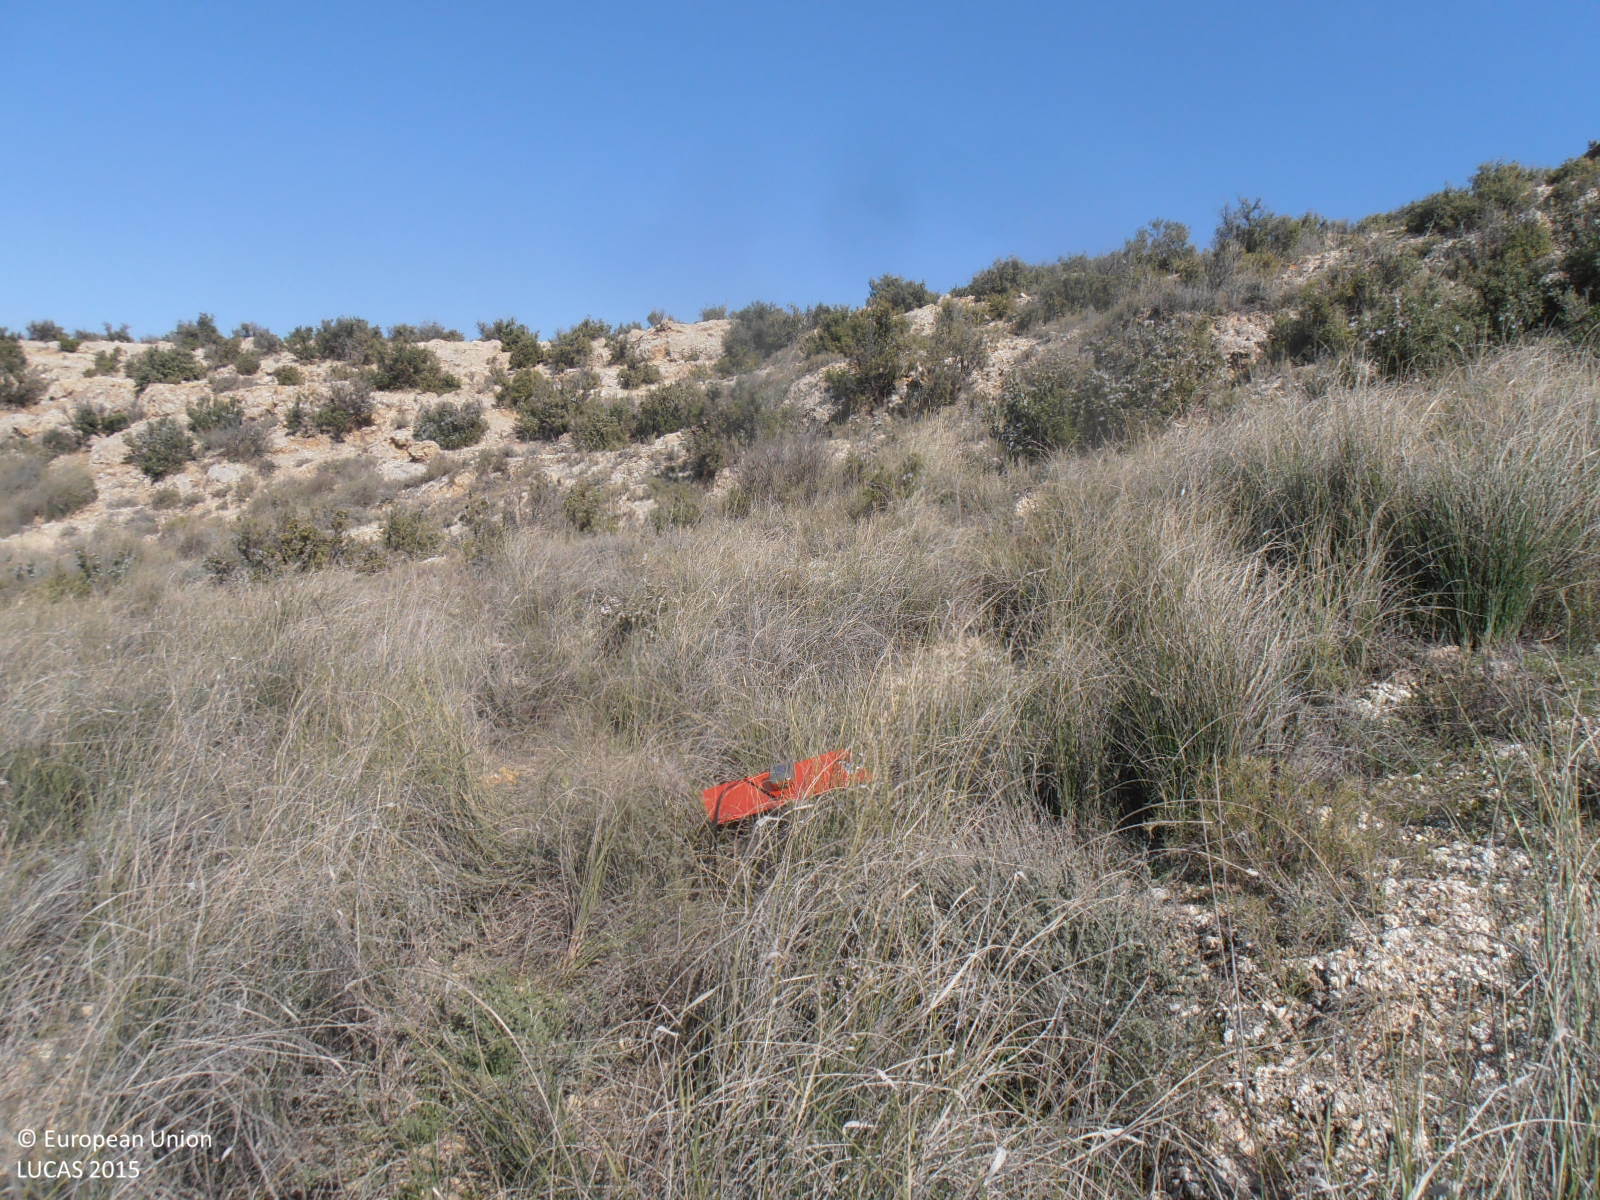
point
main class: Shrubland
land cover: Shrubland without tree cover
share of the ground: 50 - 75 %
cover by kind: shrubs 55 %, consolidated bare surface 45 %
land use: Semi-natural and natural areas not in use
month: April
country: ES
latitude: 41.5467
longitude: -0.9666
